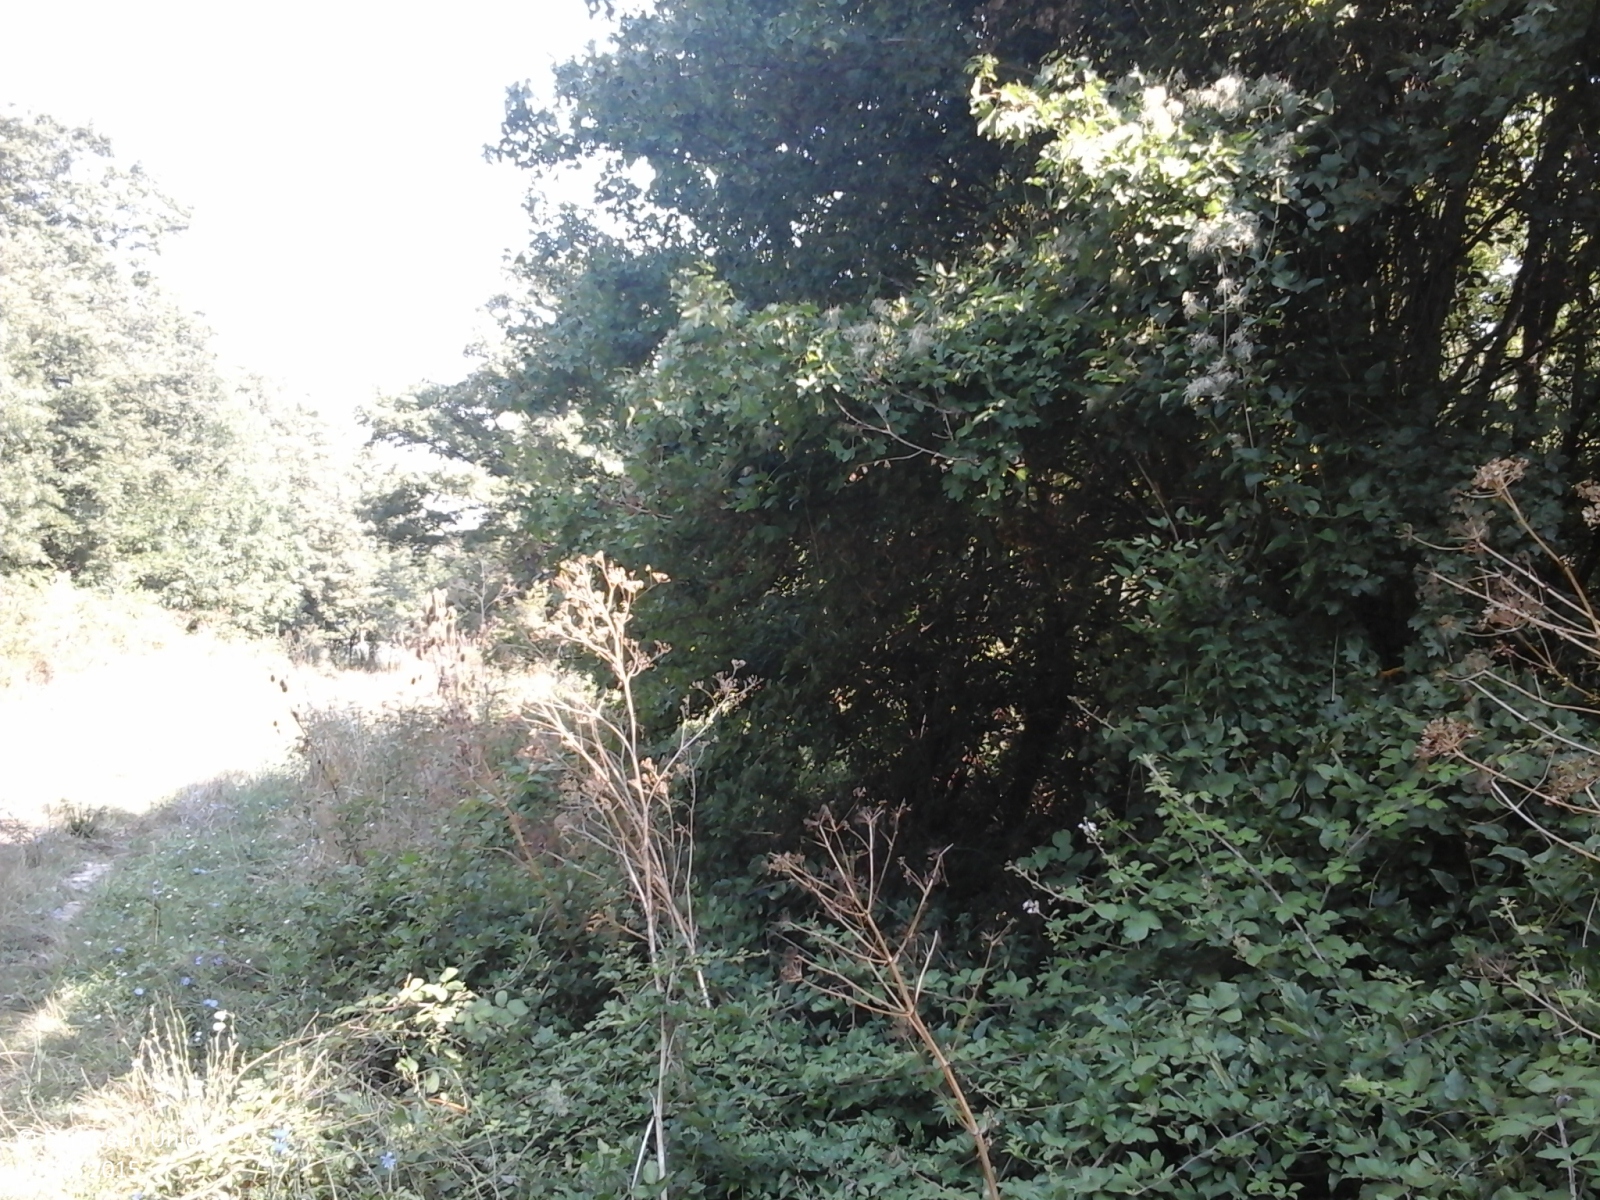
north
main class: Woodland
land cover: Broadleaved woodland
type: thermophilous deciduous forest
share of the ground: > 75 %
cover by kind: broadleaved forest trees 80 %, shrubs 15 %, herbaceous plants 5 %
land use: Forestry
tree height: > 5 m
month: August
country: IT
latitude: 41.3484
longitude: 15.1093
